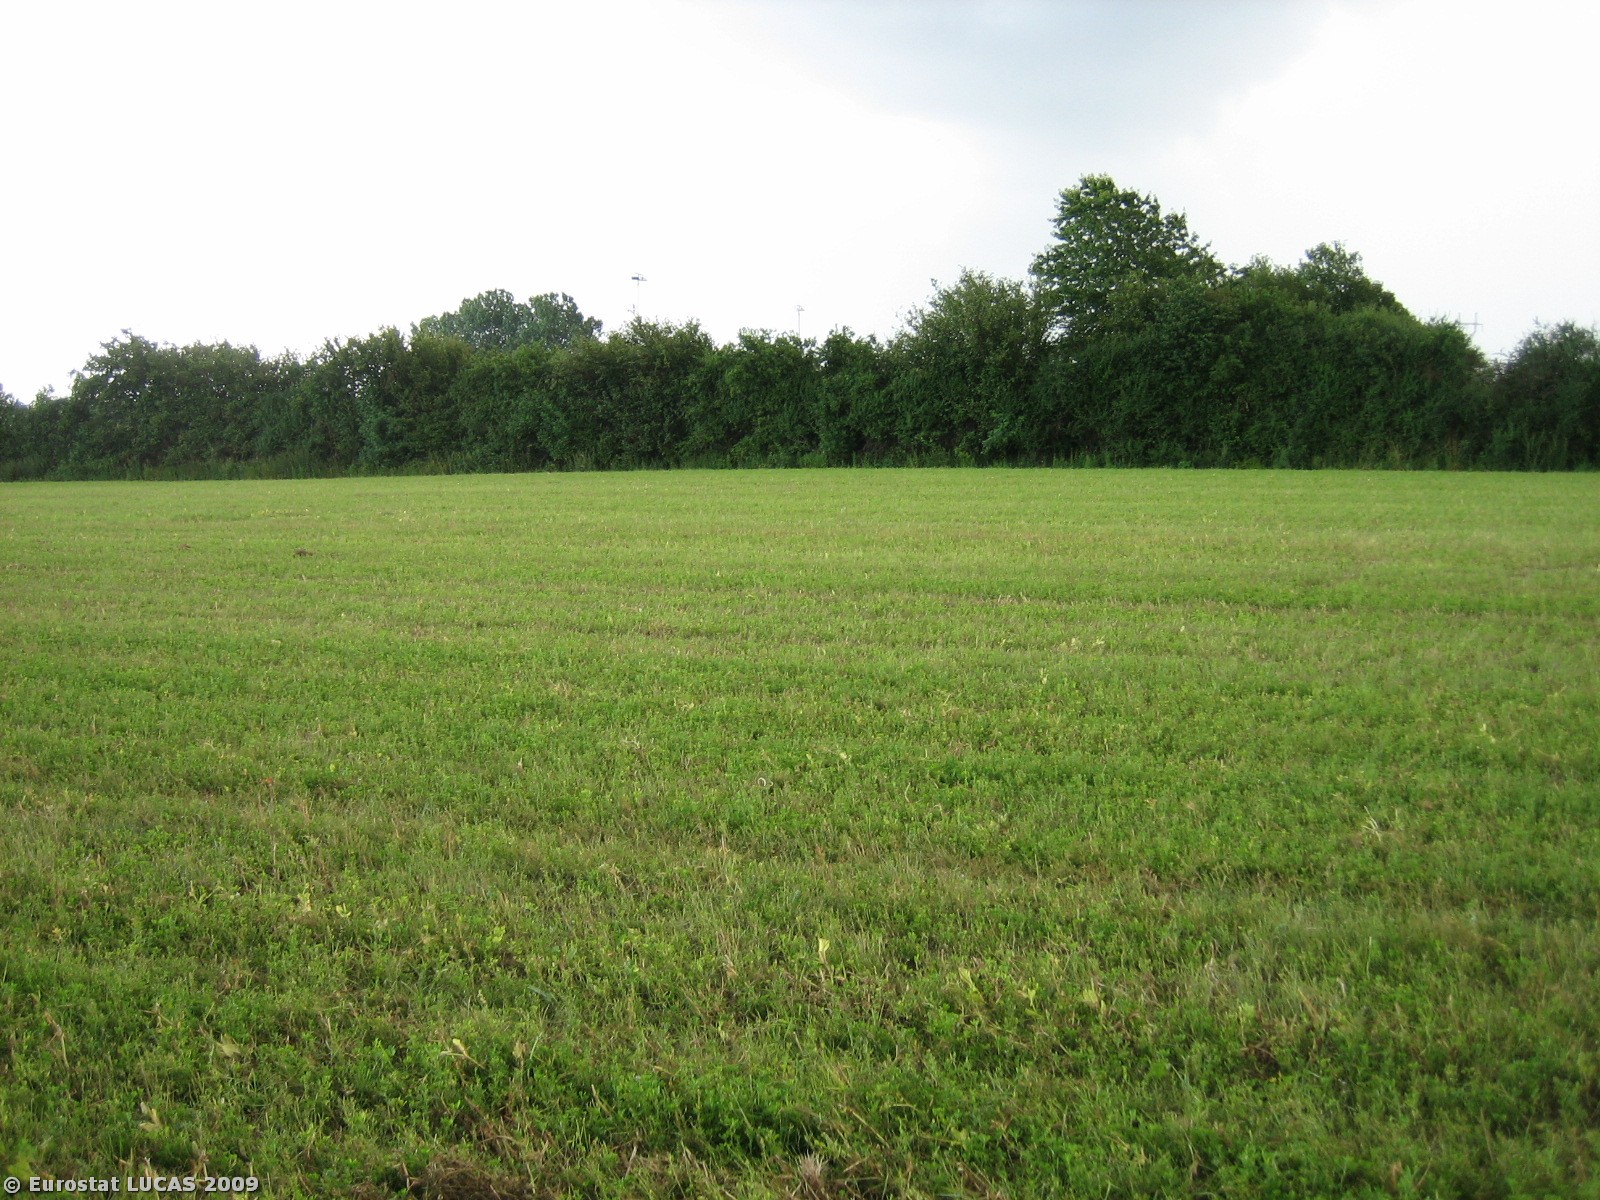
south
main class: Cropland
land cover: Dry pulses
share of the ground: 10 - 25 %
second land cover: Clovers
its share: 50 - 75 %
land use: Agriculture (excluding fallow land and kitchen gardens)
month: July
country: DK
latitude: 55.5403
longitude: 9.6992
